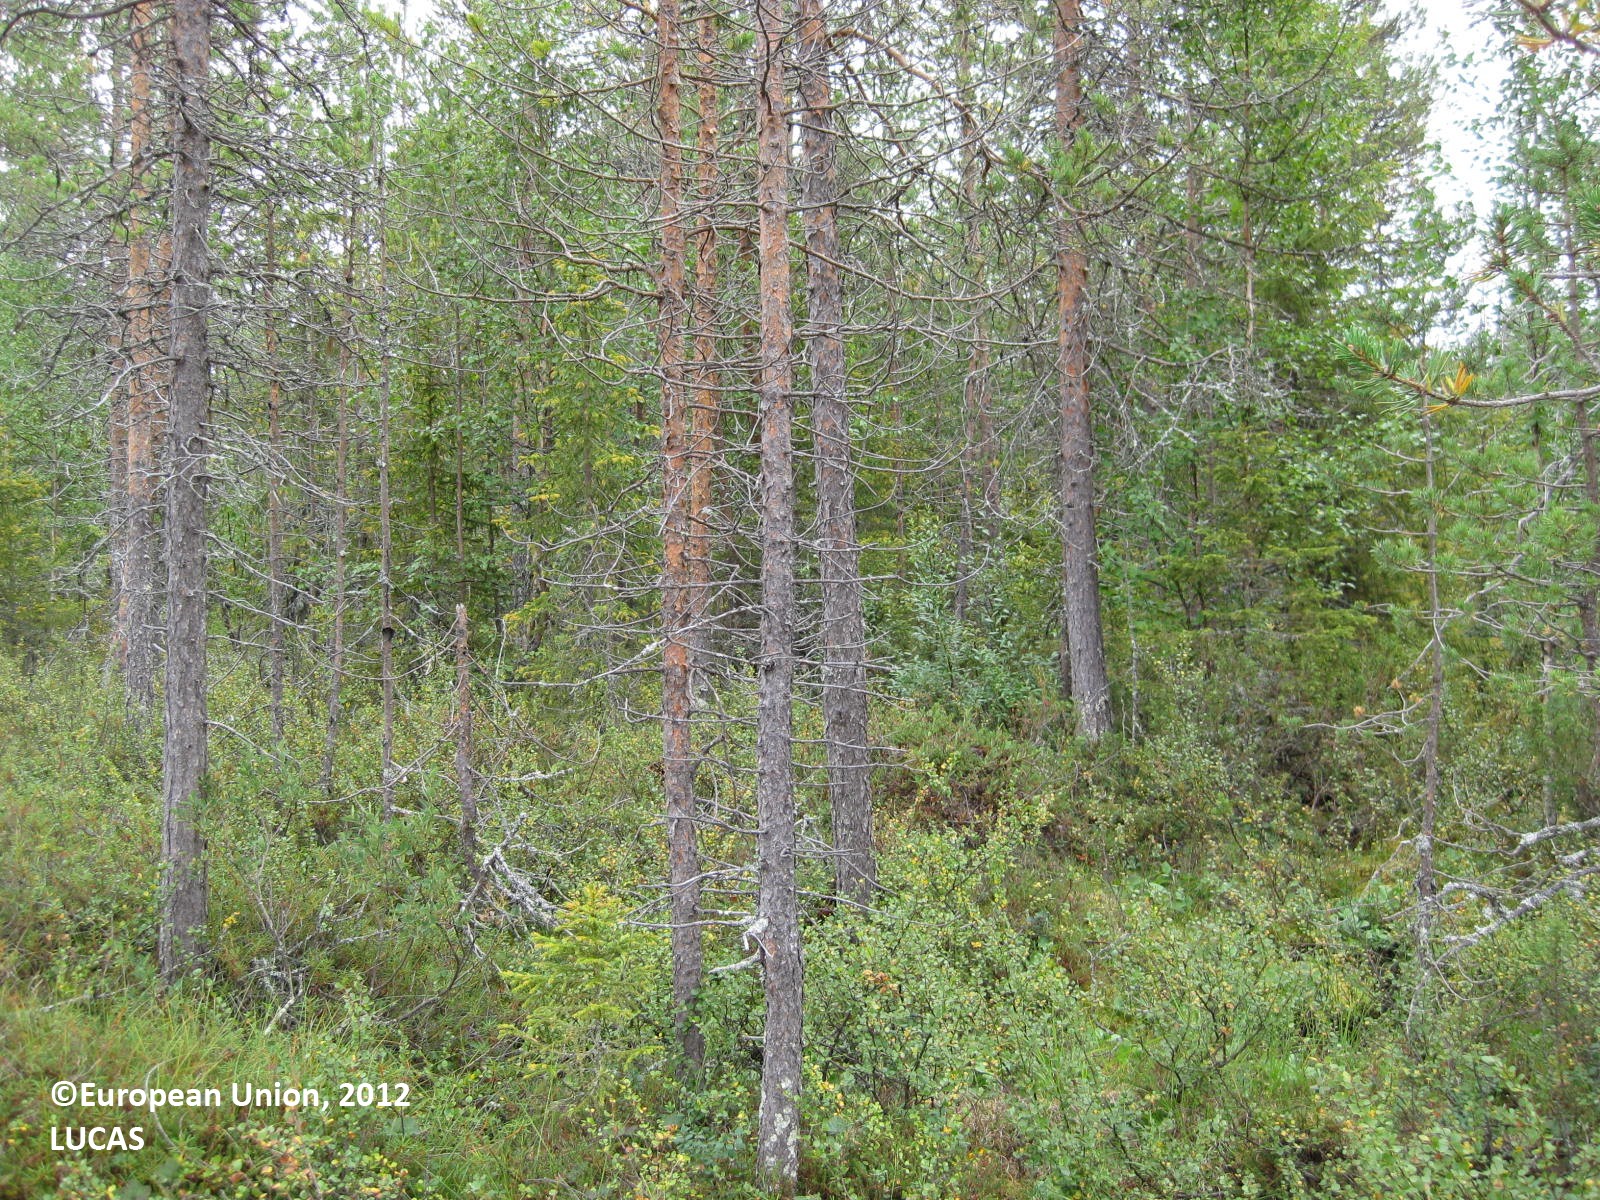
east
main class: Woodland
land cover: Pine dominated coniferous woodland
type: boreal forest
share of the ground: 50 - 75 %
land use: Forestry
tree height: > 5 m
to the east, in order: Pine dominated coniferous woodland; Pine dominated mixed woodland; Ditches and canals; Pine dominated mixed woodland; Ditches and canals; Pine dominated mixed woodland; Ditches and canals; Other mixed woodland; Ditches and canals; Other mixed woodland; Ditches and canals; Pine dominated mixed woodland
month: August
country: FI
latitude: 66.4643
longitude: 29.0855
